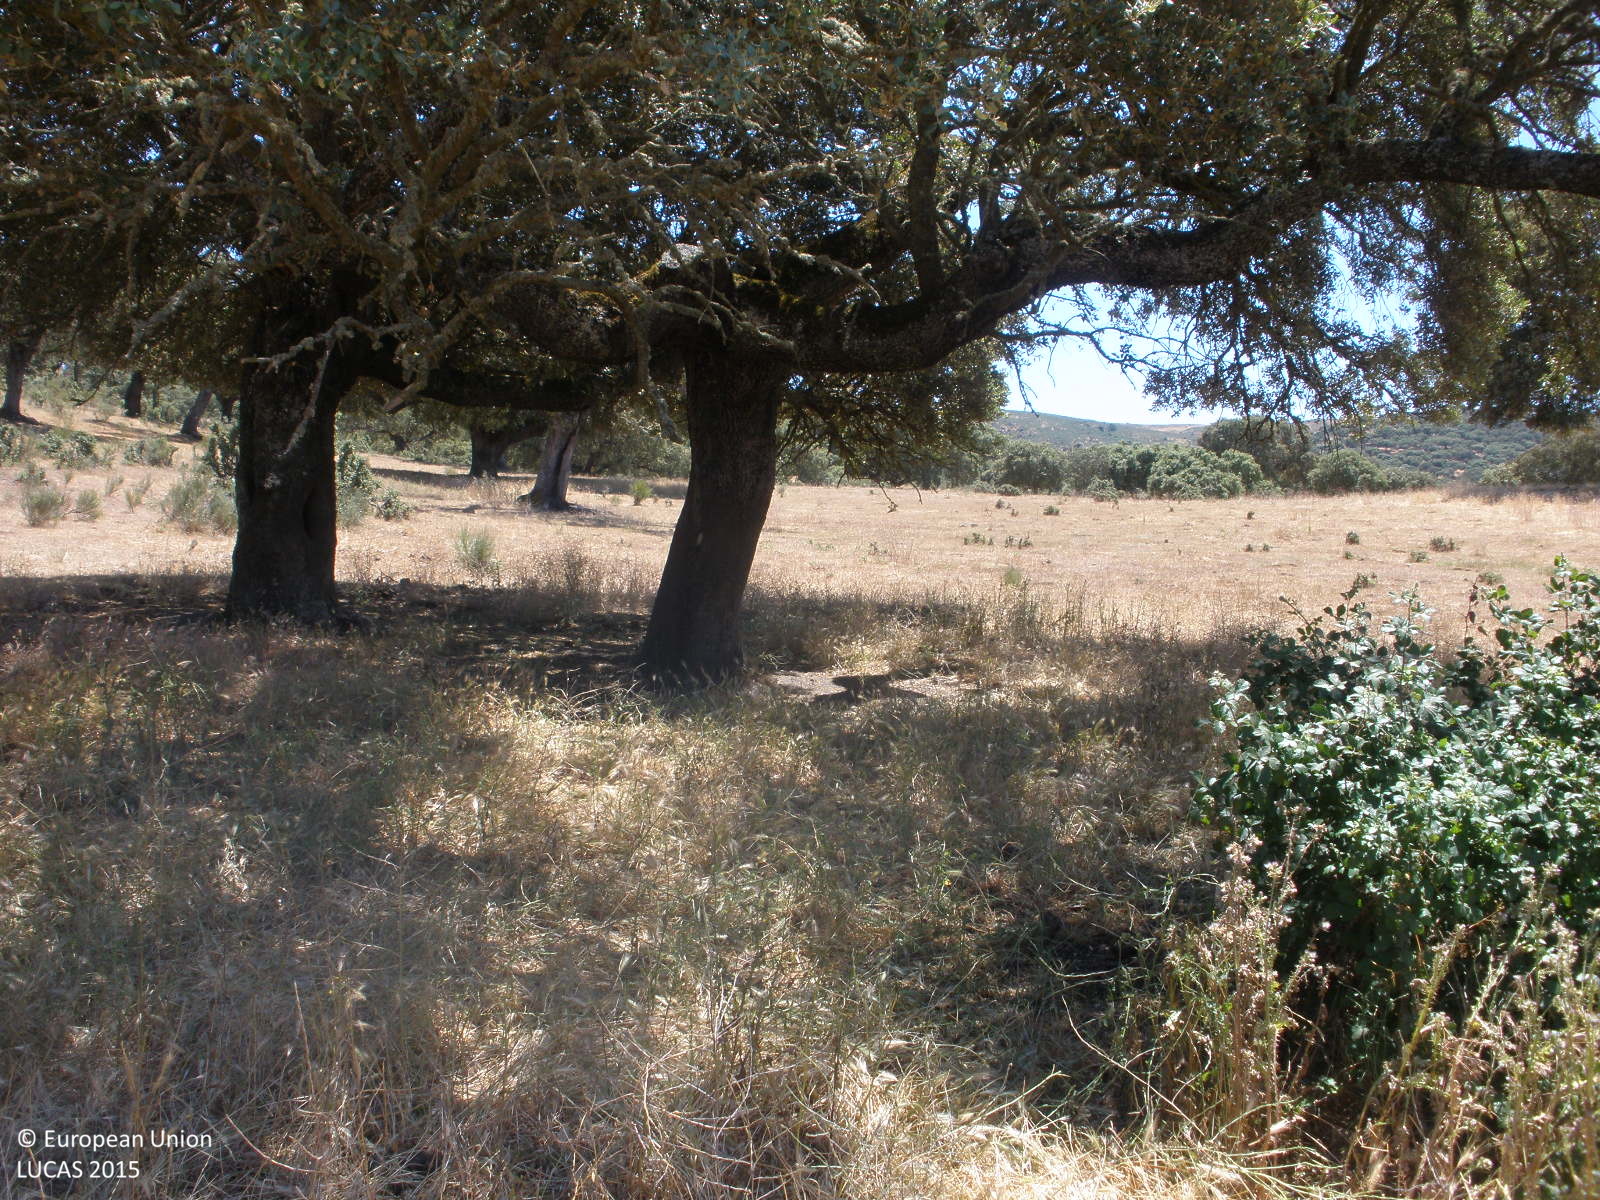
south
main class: Woodland
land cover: Broadleaved woodland
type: broadleaved evergreen forest
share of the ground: 25 - 50 %
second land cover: Grassland without tree/shrub cover
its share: > 75 %
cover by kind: herbaceous plants 60 %, broadleaved forest trees 30 %, shrubs 10 %
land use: Forestry
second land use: Agriculture (excluding fallow land and kitchen gardens)
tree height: > 5 m
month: June
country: ES
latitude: 40.4669
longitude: -6.6852
